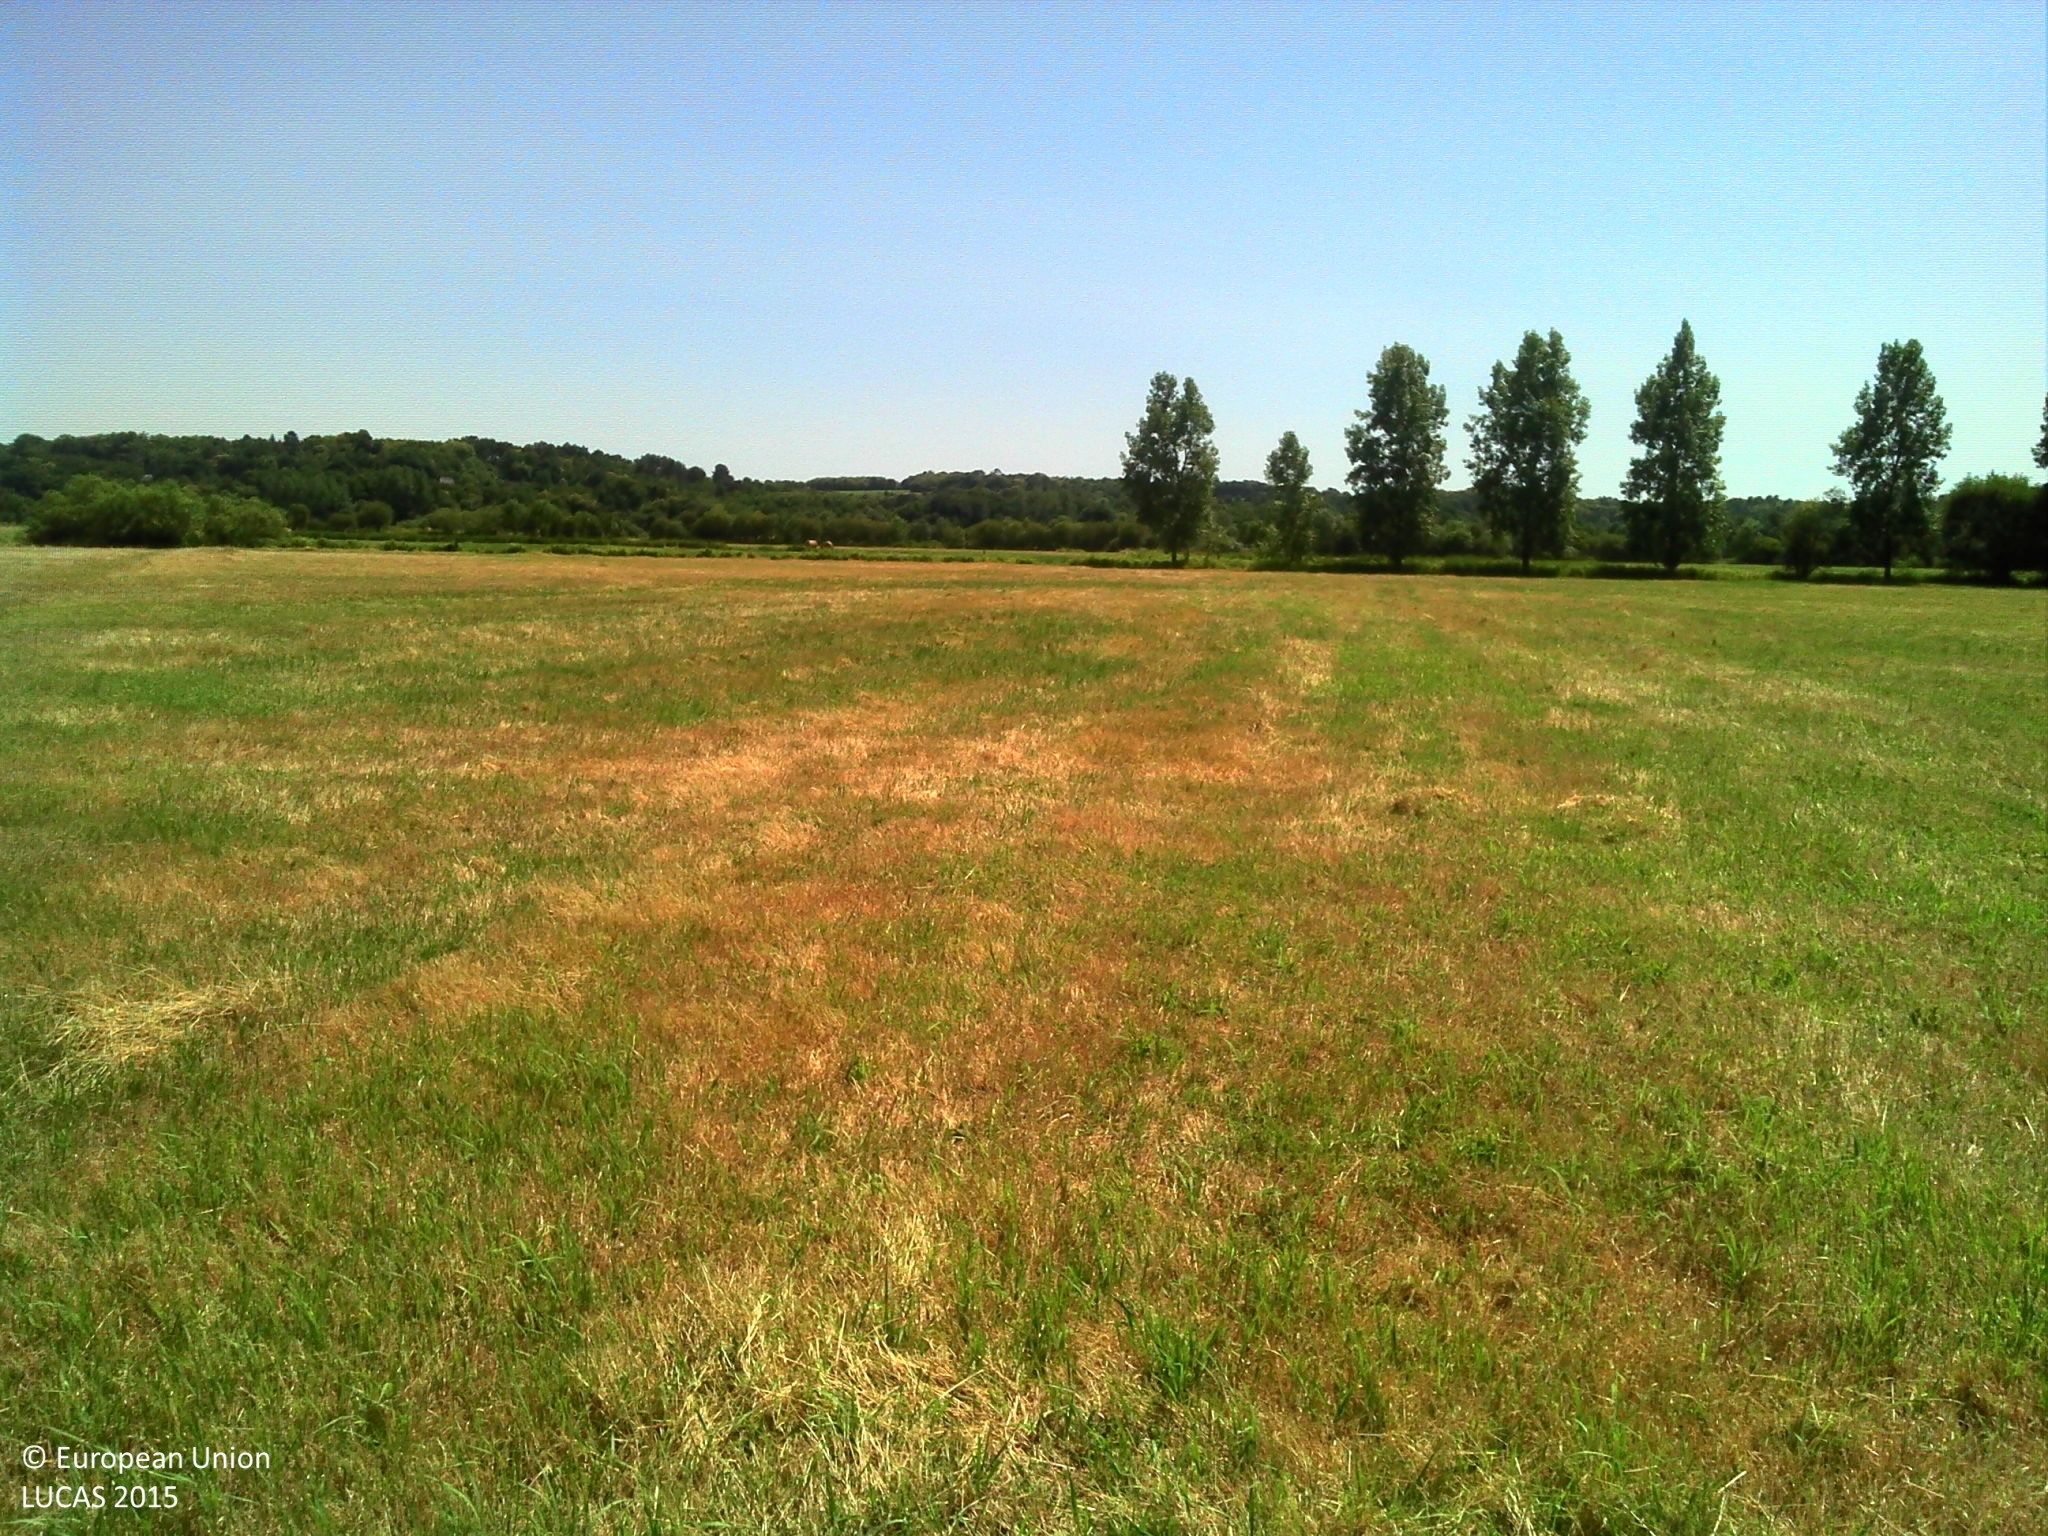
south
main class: Grassland
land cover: Grassland without tree/shrub cover
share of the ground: > 75 %
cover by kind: herbaceous plants 100 %
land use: Agriculture (excluding fallow land and kitchen gardens)
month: July
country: FR
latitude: 47.6718
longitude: -2.0242
